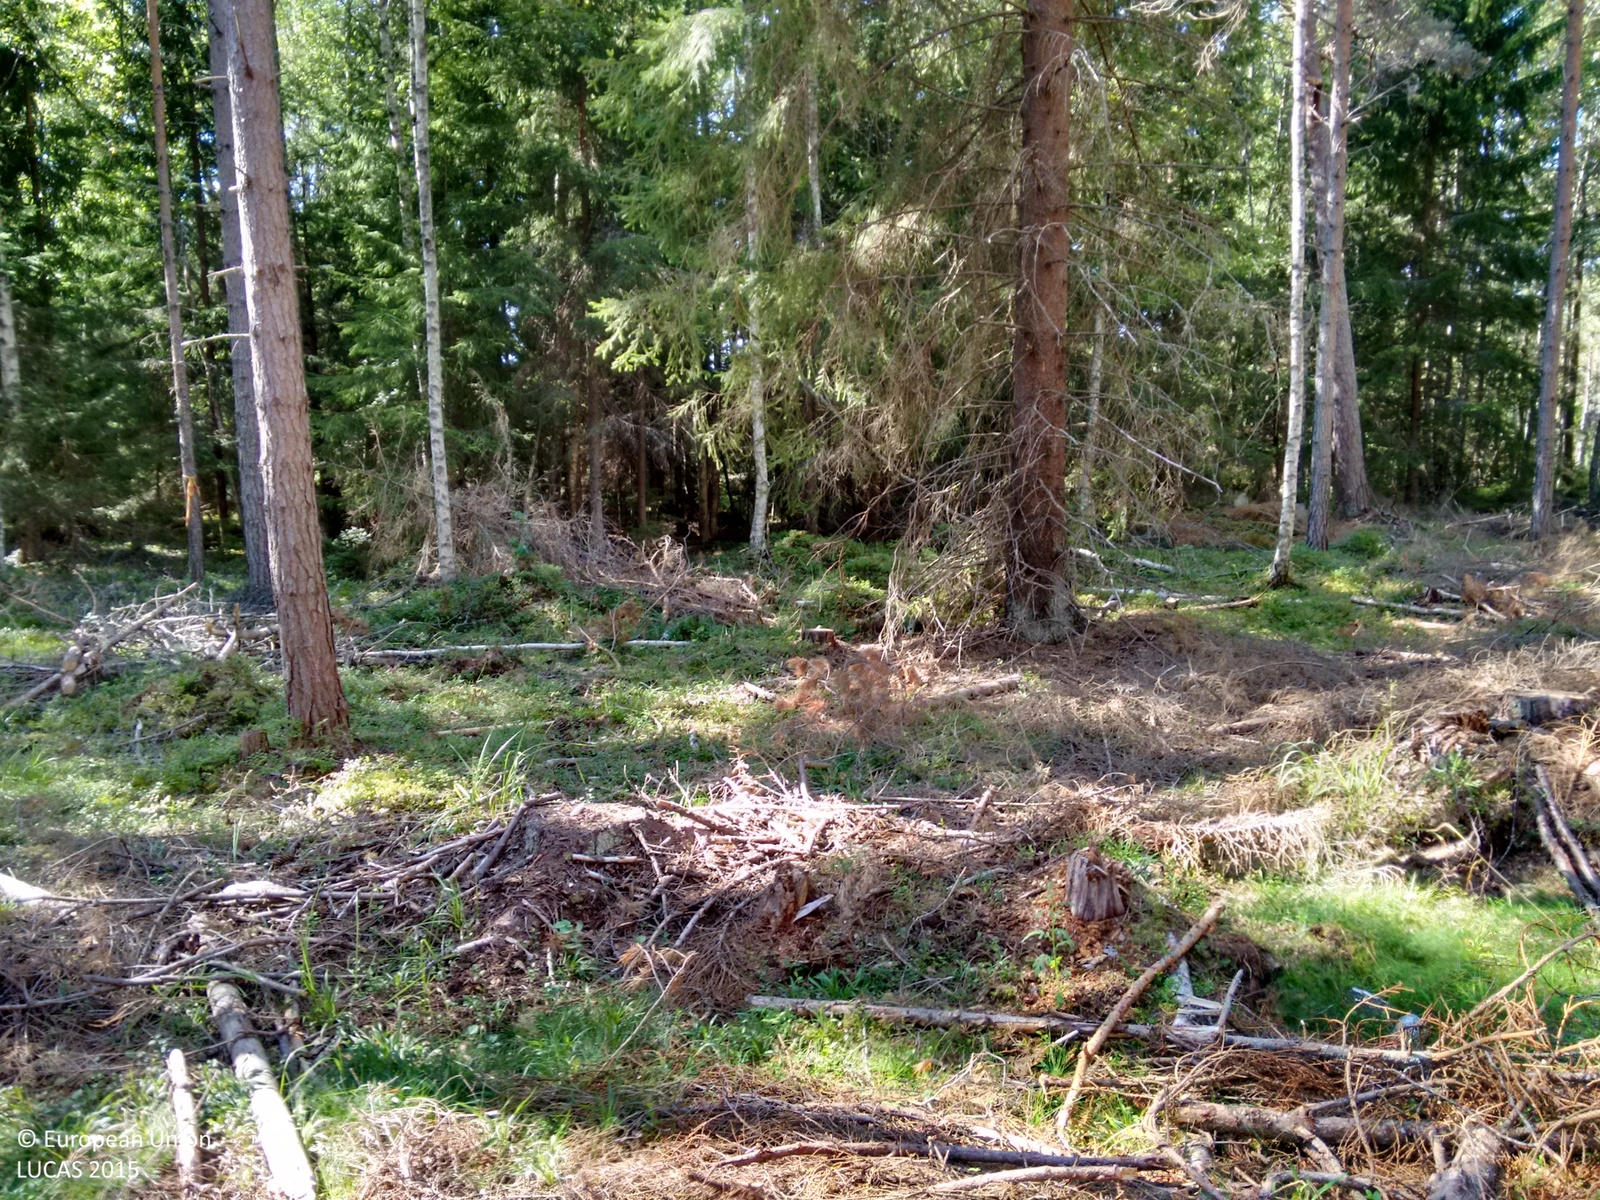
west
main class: Woodland
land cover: Pine dominated coniferous woodland
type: hemiboreal forest and nemoral coniferous forest and mixed broadleaved-coniferous forest
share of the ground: > 75 %
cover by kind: coniferous forest trees 80 %, shrubs 5 %, herbaceous plants 5 %, lichens and mosses 5 %
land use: Forestry
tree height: > 5 m
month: August
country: FI
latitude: 60.2523
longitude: 19.5973
